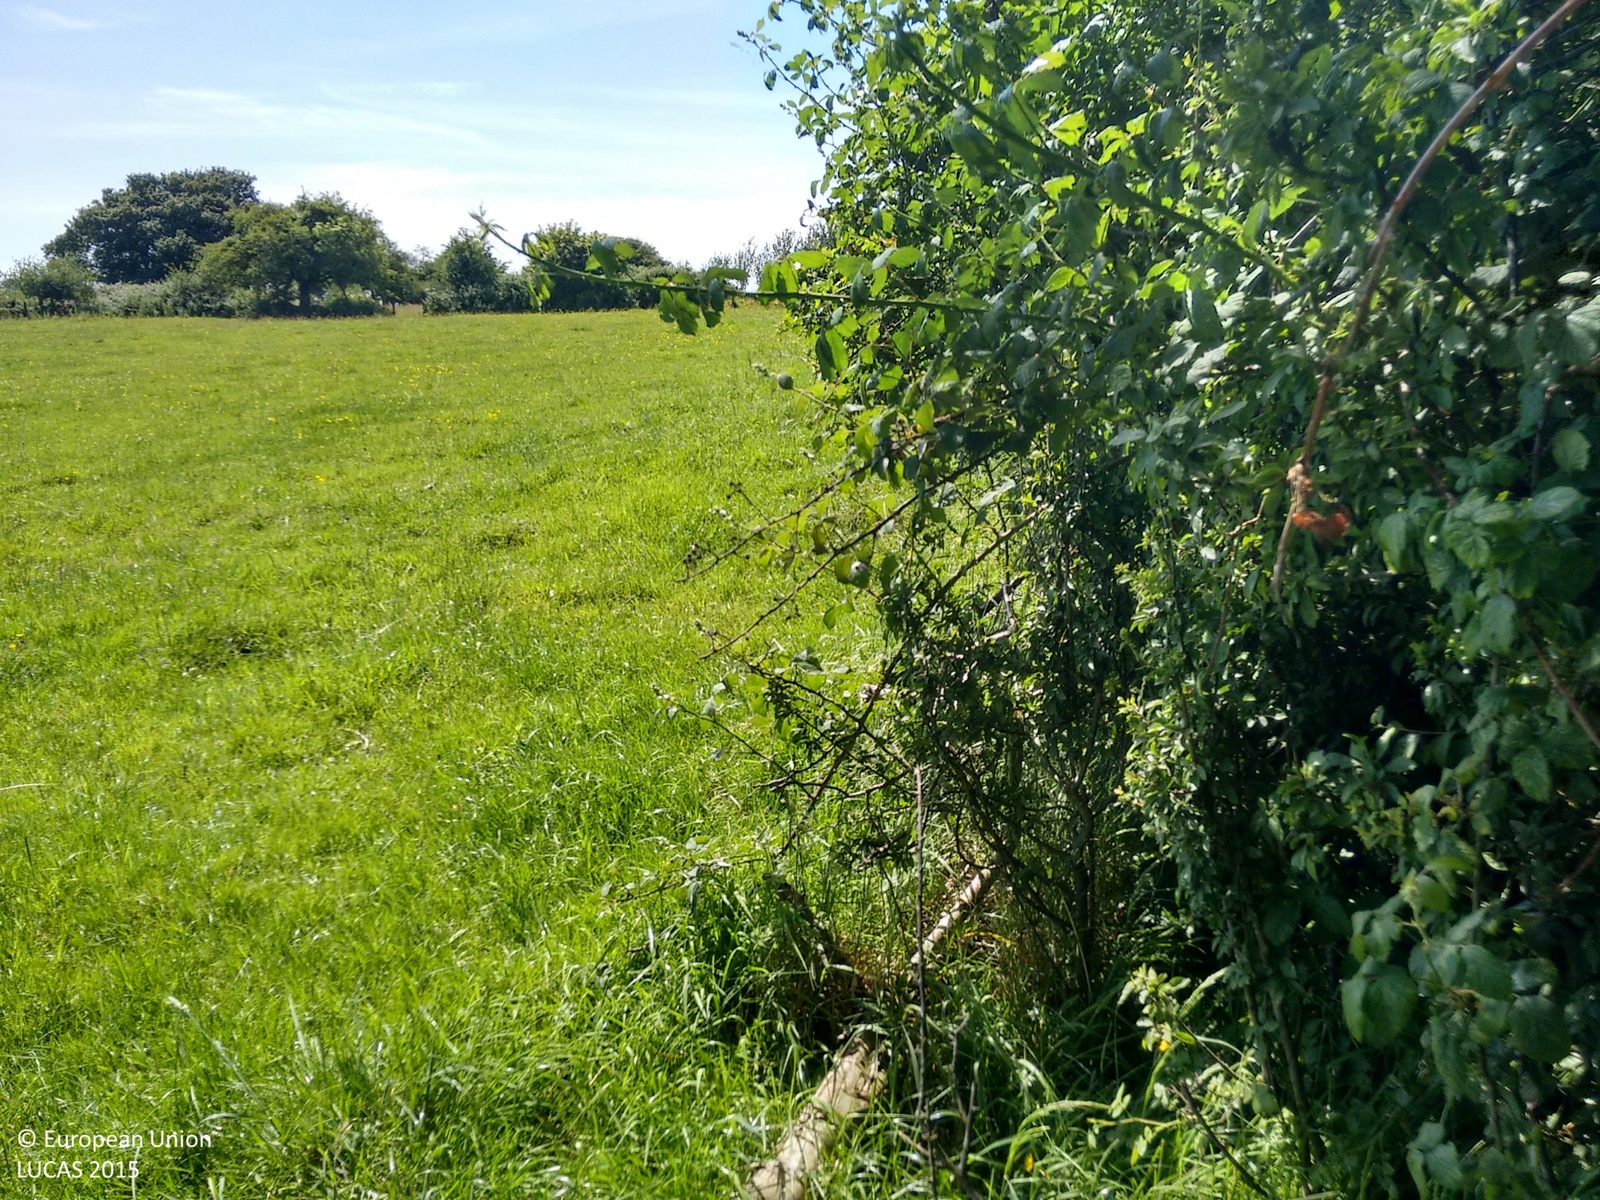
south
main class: Grassland
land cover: Grassland without tree/shrub cover
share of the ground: > 75 %
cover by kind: herbaceous plants 100 %
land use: Energy production
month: July
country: GB
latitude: 51.2004
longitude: -2.5323
